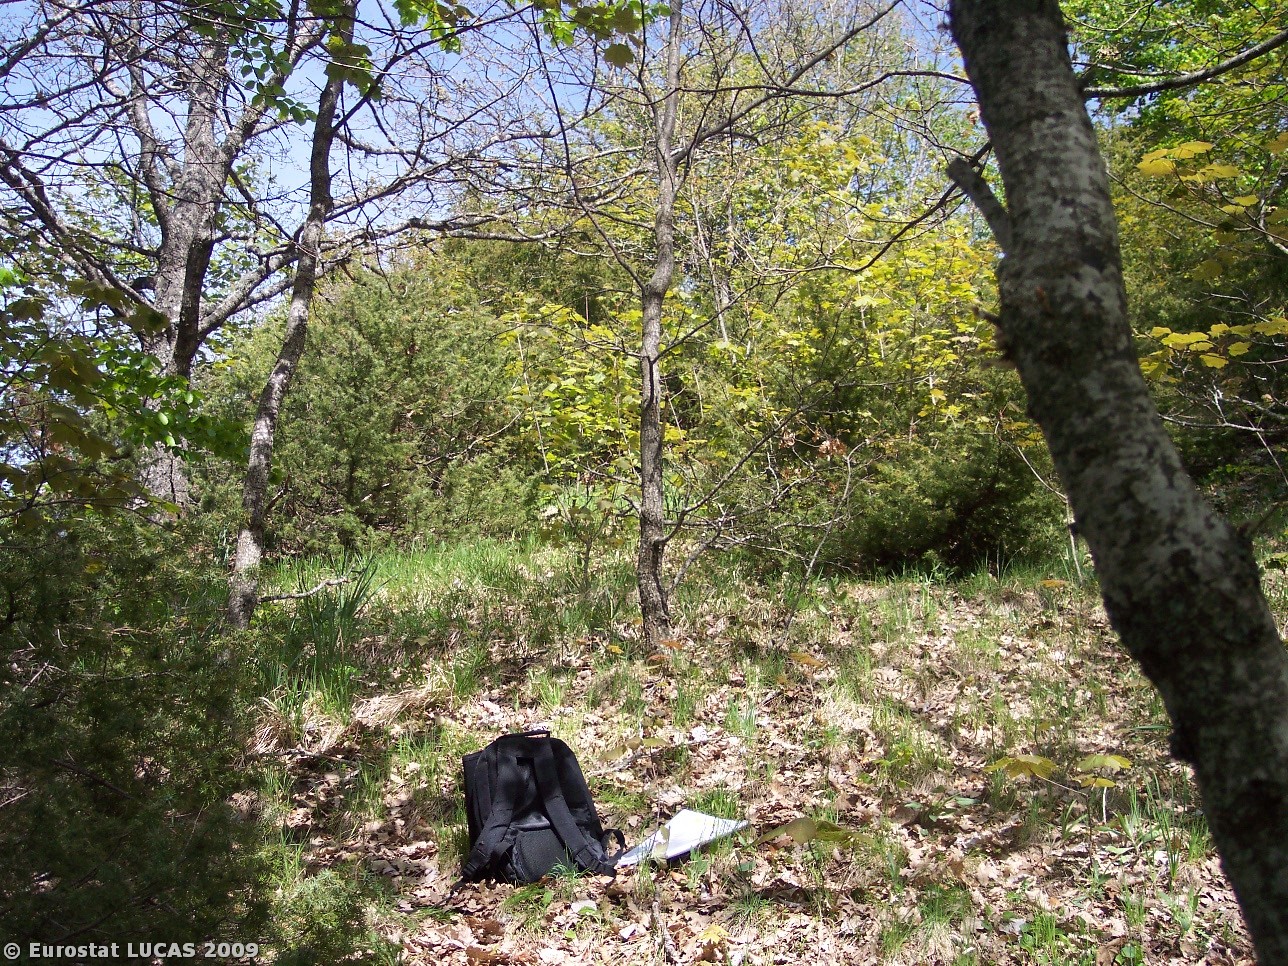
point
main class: Woodland
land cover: Broadleaved woodland
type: thermophilous deciduous forest
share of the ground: > 75 %
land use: Forestry
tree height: > 5 m
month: May
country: IT
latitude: 42.8303
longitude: 12.8662
